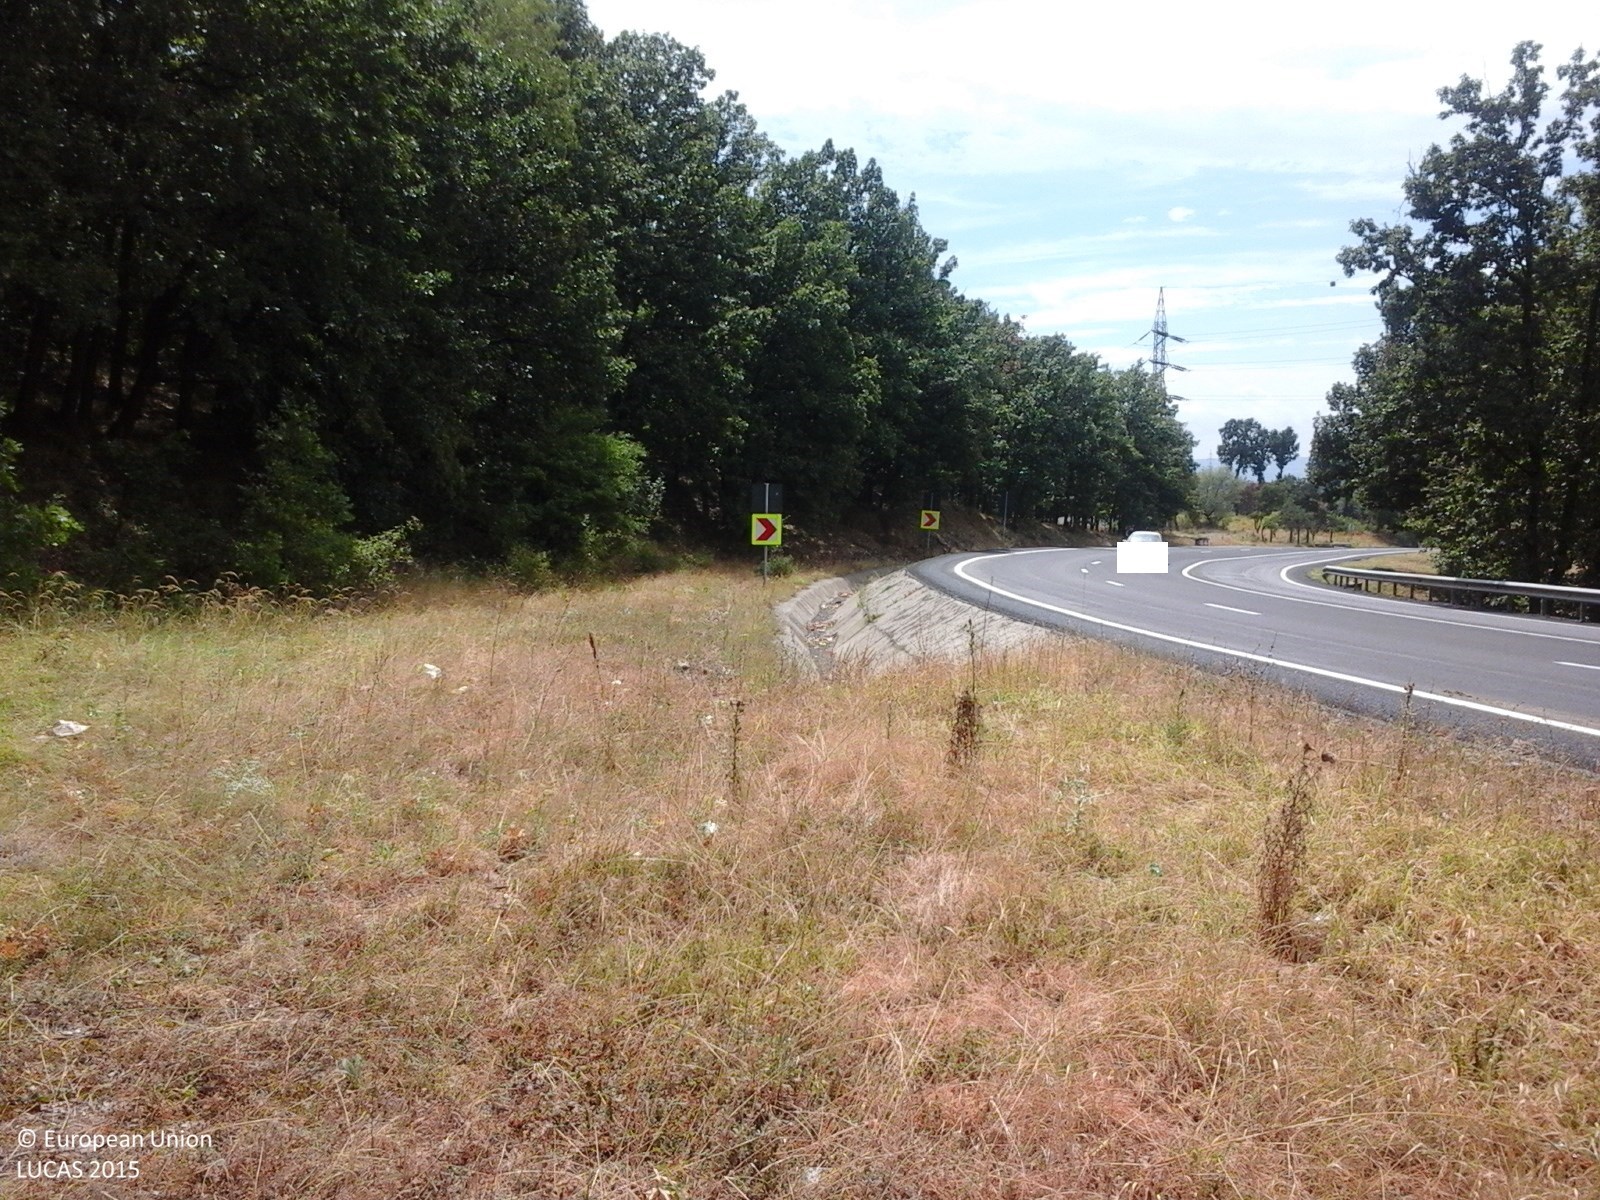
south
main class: Grassland
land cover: Grassland without tree/shrub cover
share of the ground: > 75 %
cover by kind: herbaceous plants 100 %
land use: Semi-natural and natural areas not in use
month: August
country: RO
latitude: 44.6142
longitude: 22.7834
